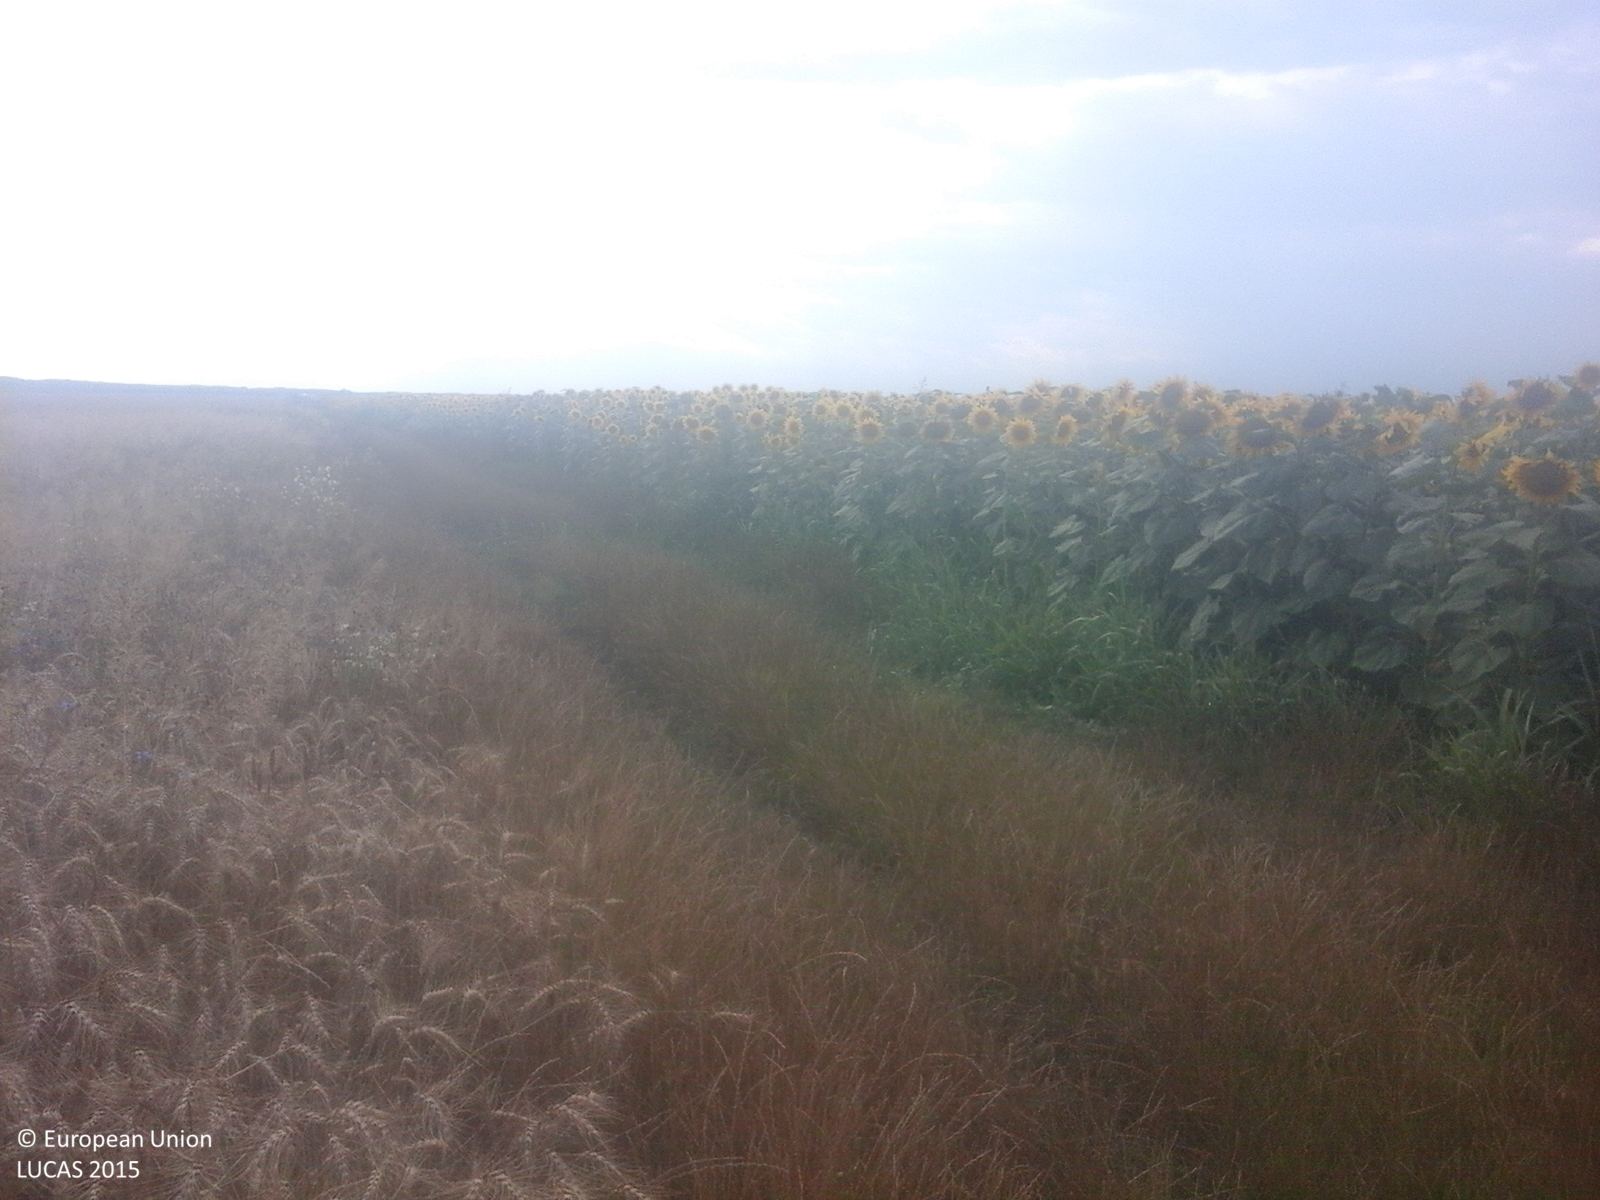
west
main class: Cropland
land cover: Common wheat
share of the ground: > 75 %
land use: Agriculture (excluding fallow land and kitchen gardens)
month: July
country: RO
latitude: 43.7602
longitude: 24.6619
